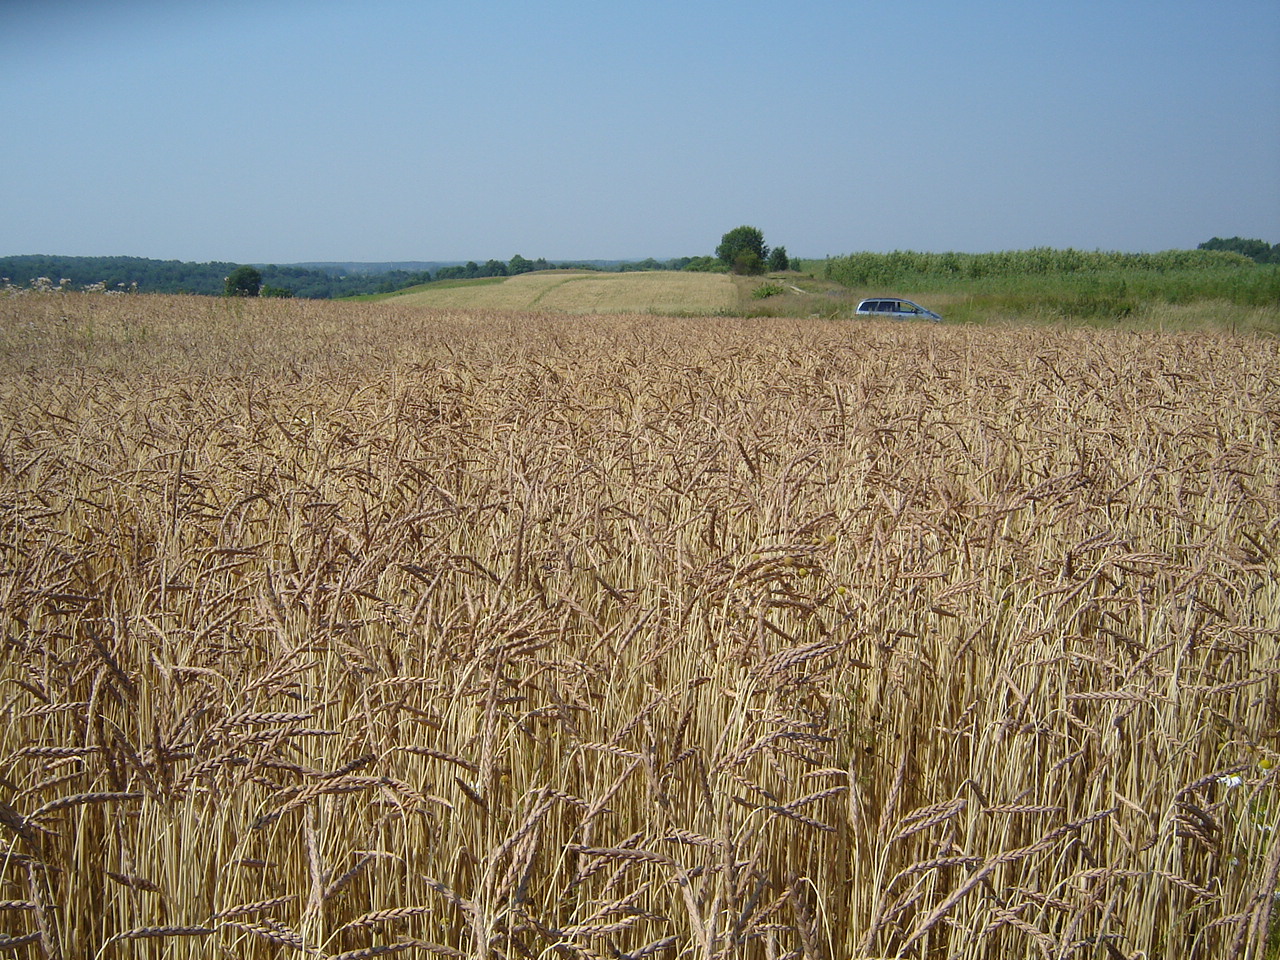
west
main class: Cropland
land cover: Common wheat
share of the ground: > 75 %
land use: Agriculture (excluding fallow land and kitchen gardens)
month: August
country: LT
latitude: 55.0752
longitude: 25.3296
